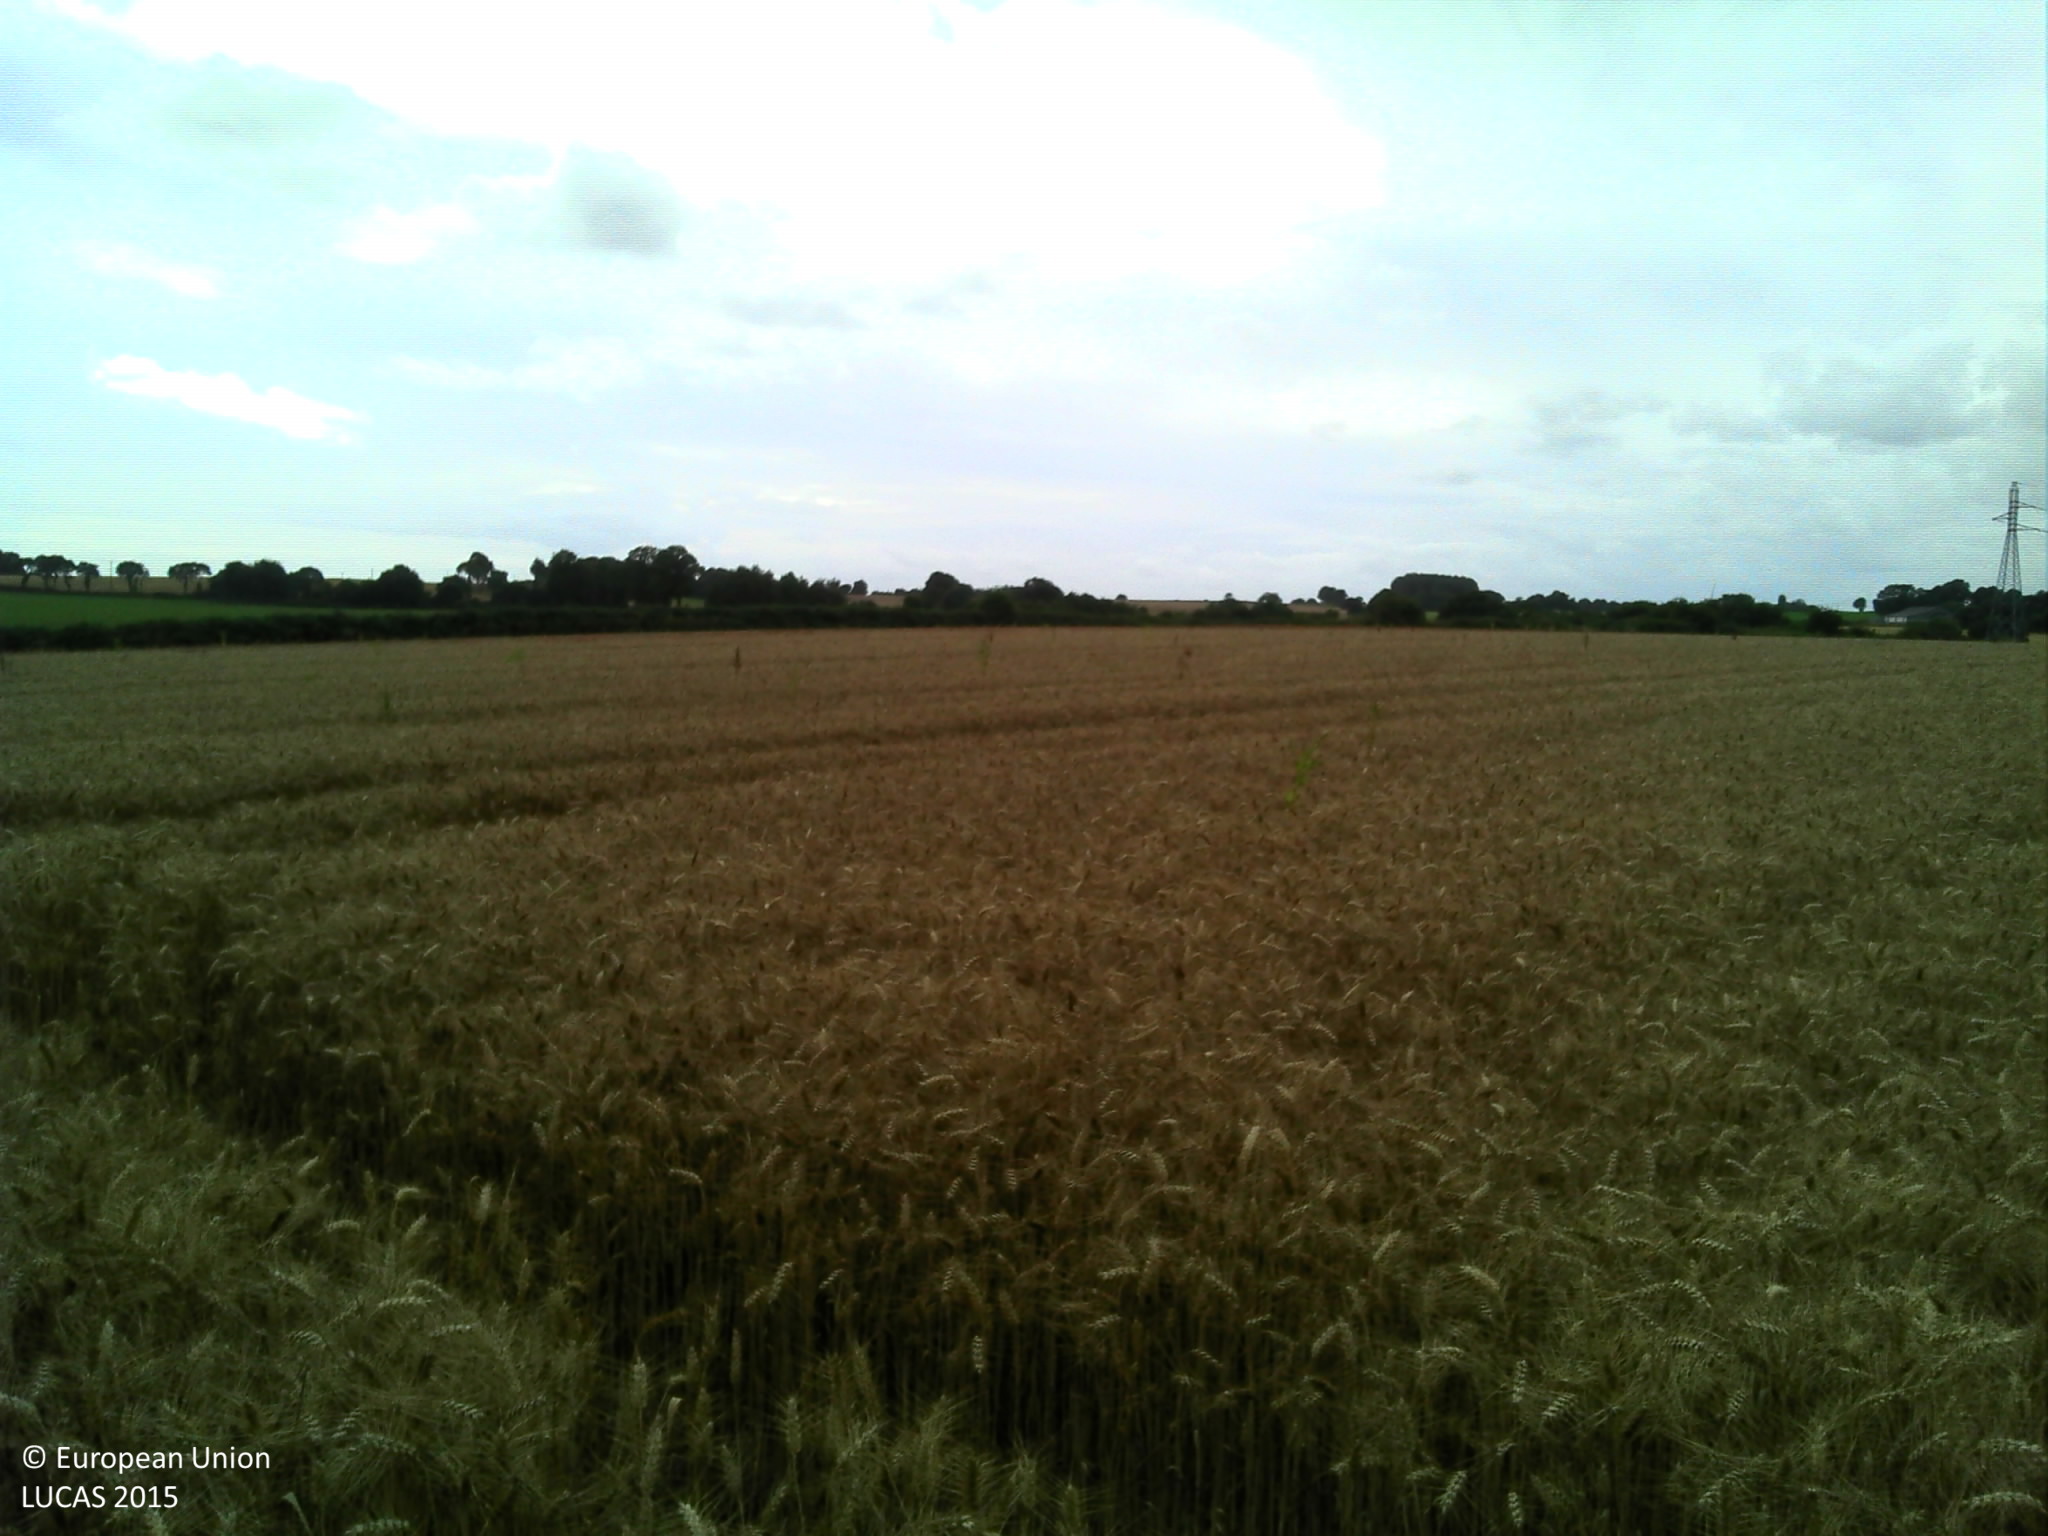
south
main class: Cropland
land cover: Common wheat
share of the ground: > 75 %
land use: Agriculture (excluding fallow land and kitchen gardens)
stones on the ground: 25 - 50 %
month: August
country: FR
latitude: 48.2601
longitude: -3.2336
